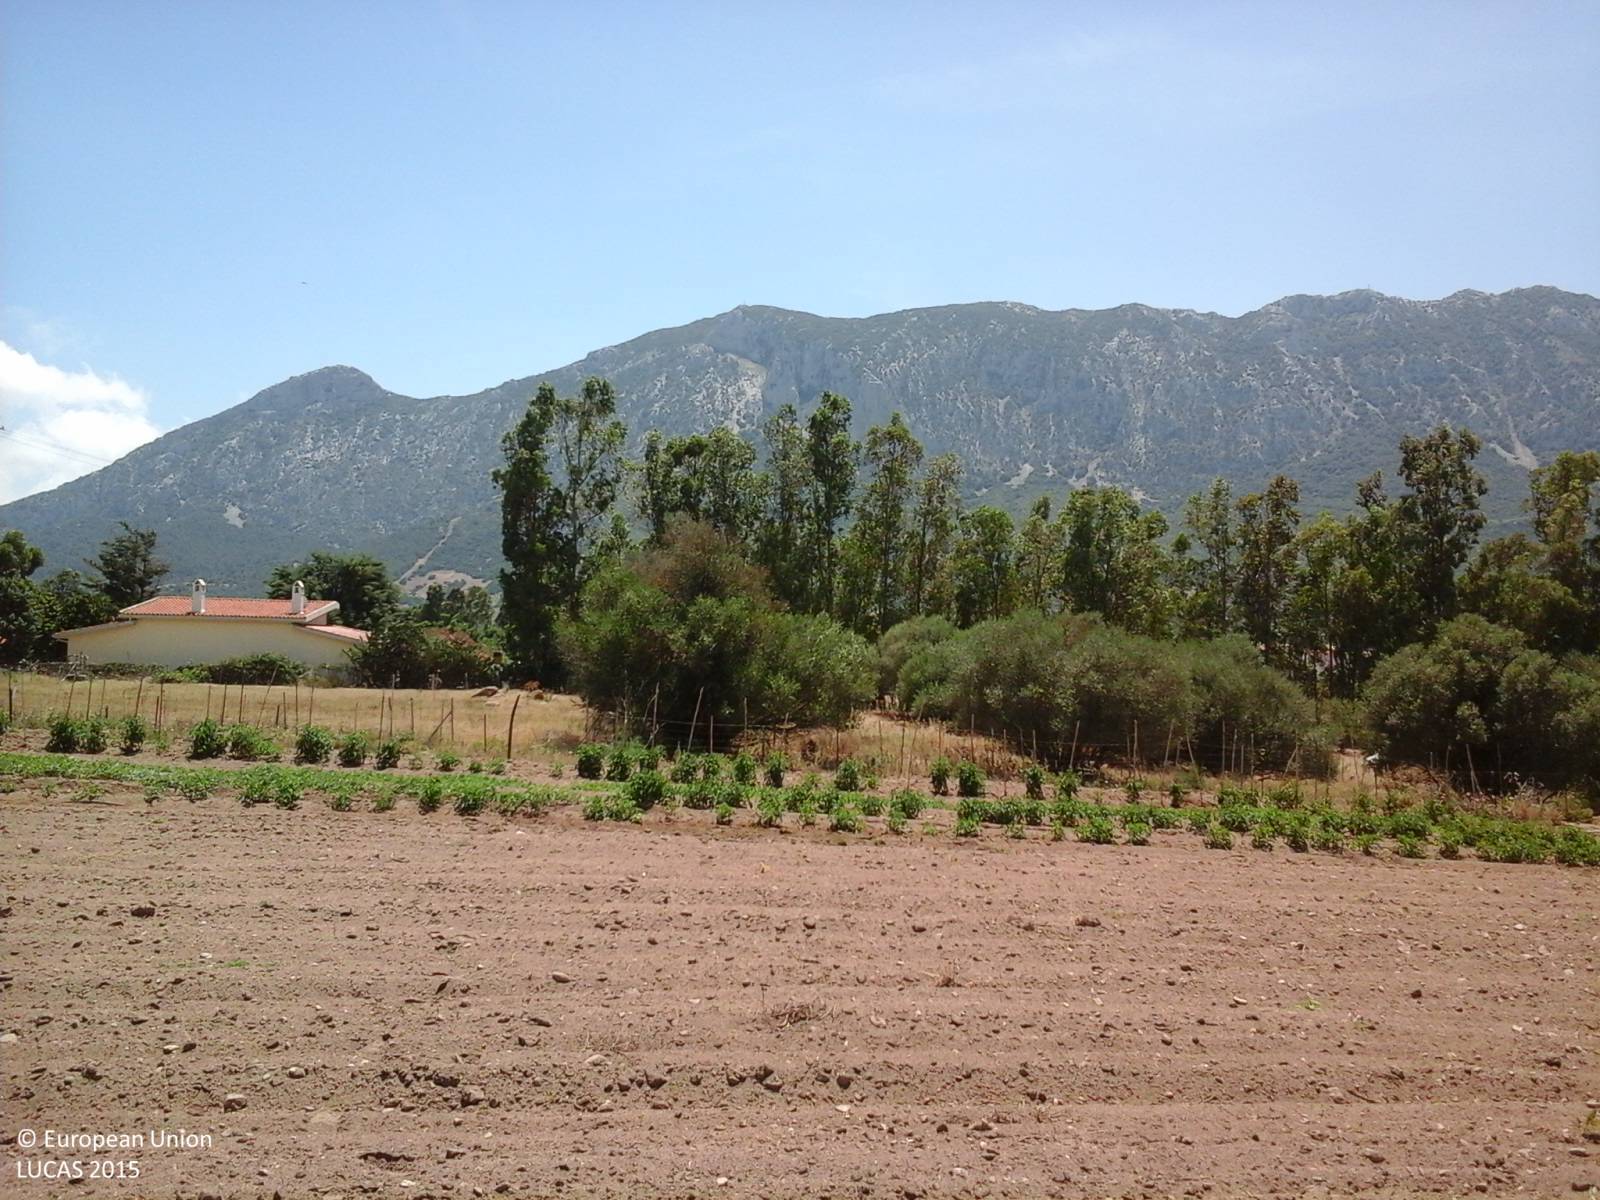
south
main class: Cropland
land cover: Tomatoes
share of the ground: > 75 %
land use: Kitchen garden
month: June
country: IT
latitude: 40.4115
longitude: 9.6366
